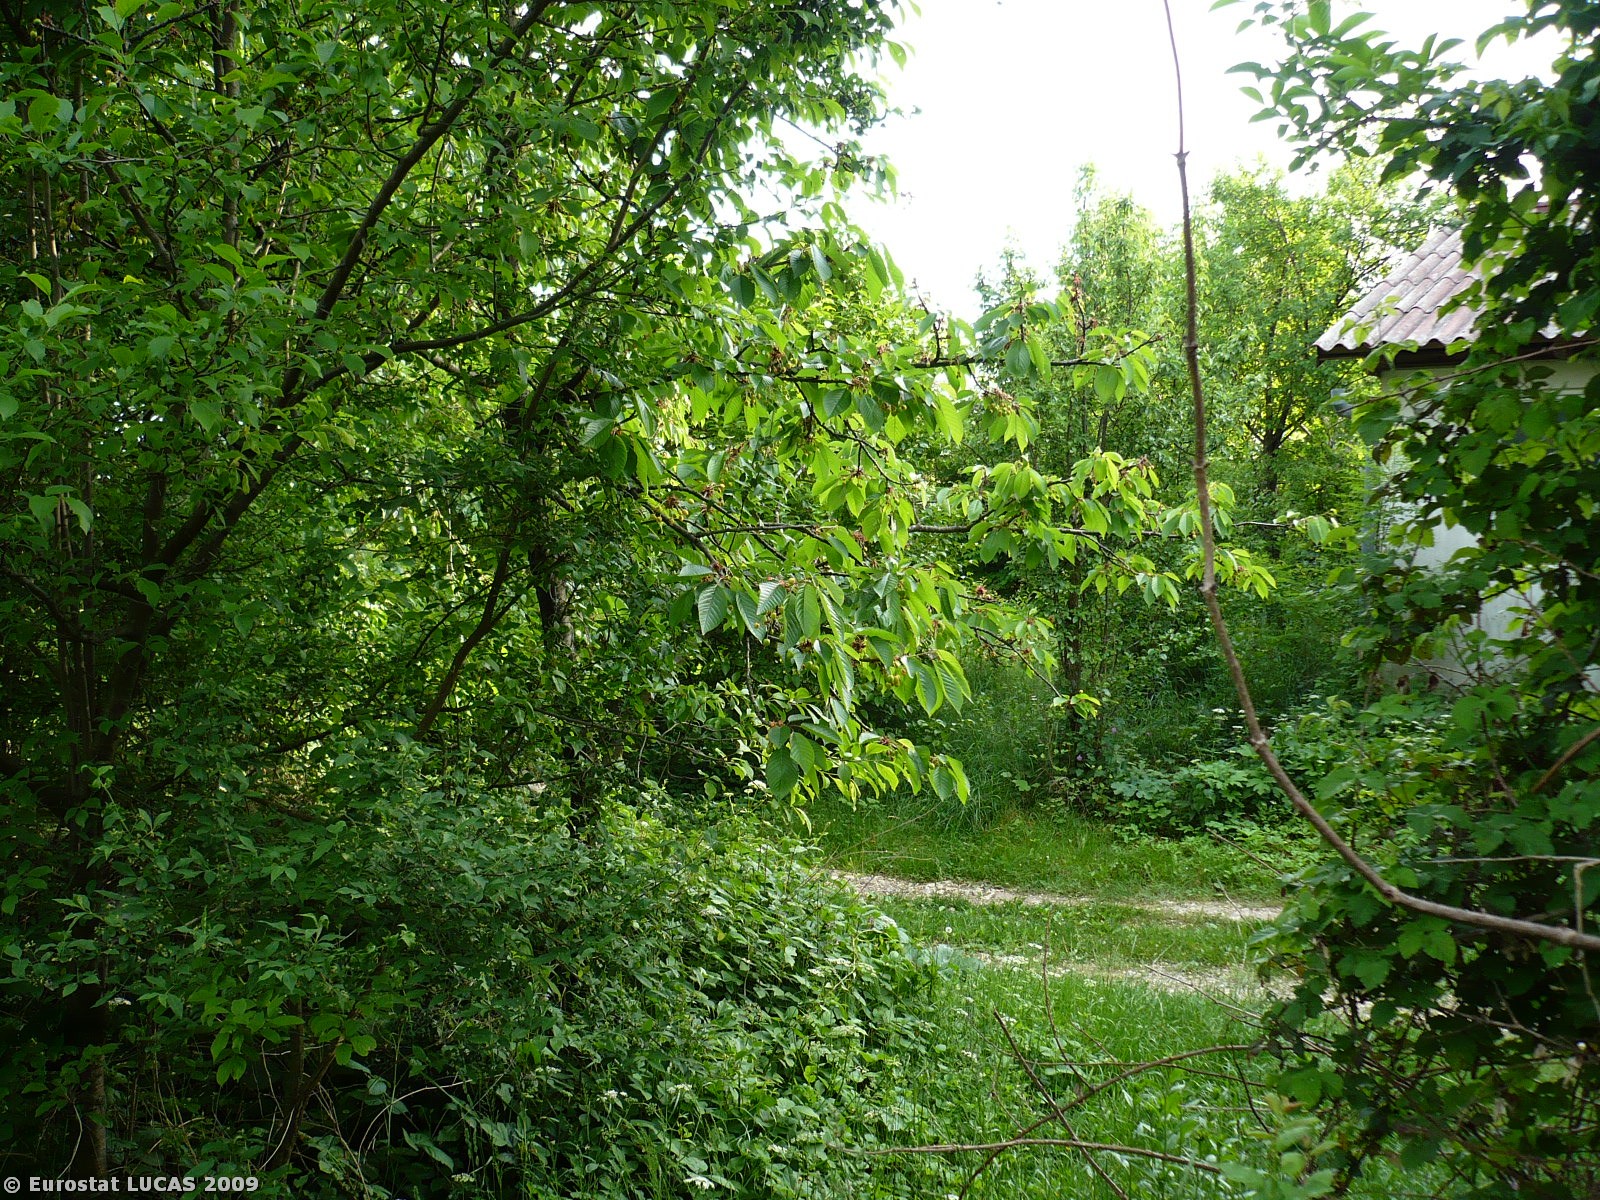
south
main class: Shrubland
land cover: Shrubland with sparse tree cover
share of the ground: 25 - 50 %
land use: Unused
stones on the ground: < 10 %
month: May
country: SI
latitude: 45.9636
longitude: 13.6738
